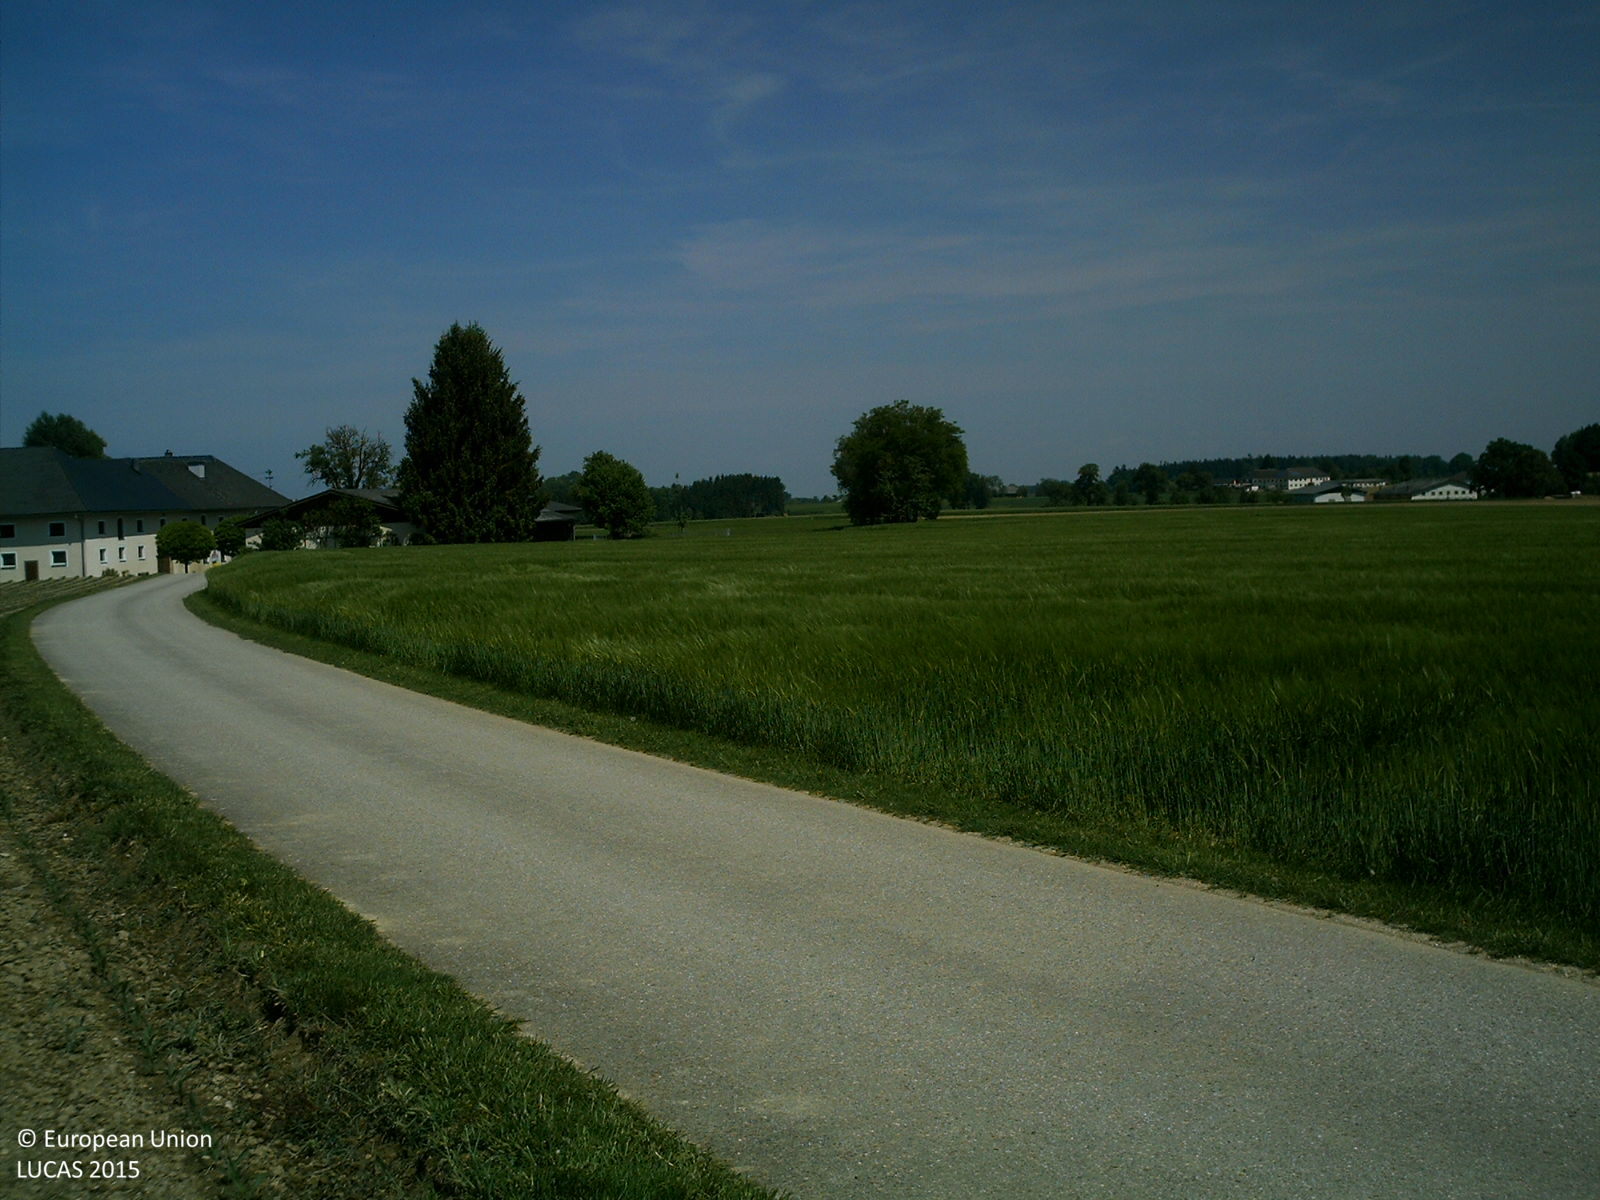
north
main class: Cropland
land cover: Maize
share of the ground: < 10 %
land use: Agriculture (excluding fallow land and kitchen gardens)
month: May
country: AT
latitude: 47.9886
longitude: 14.0059
